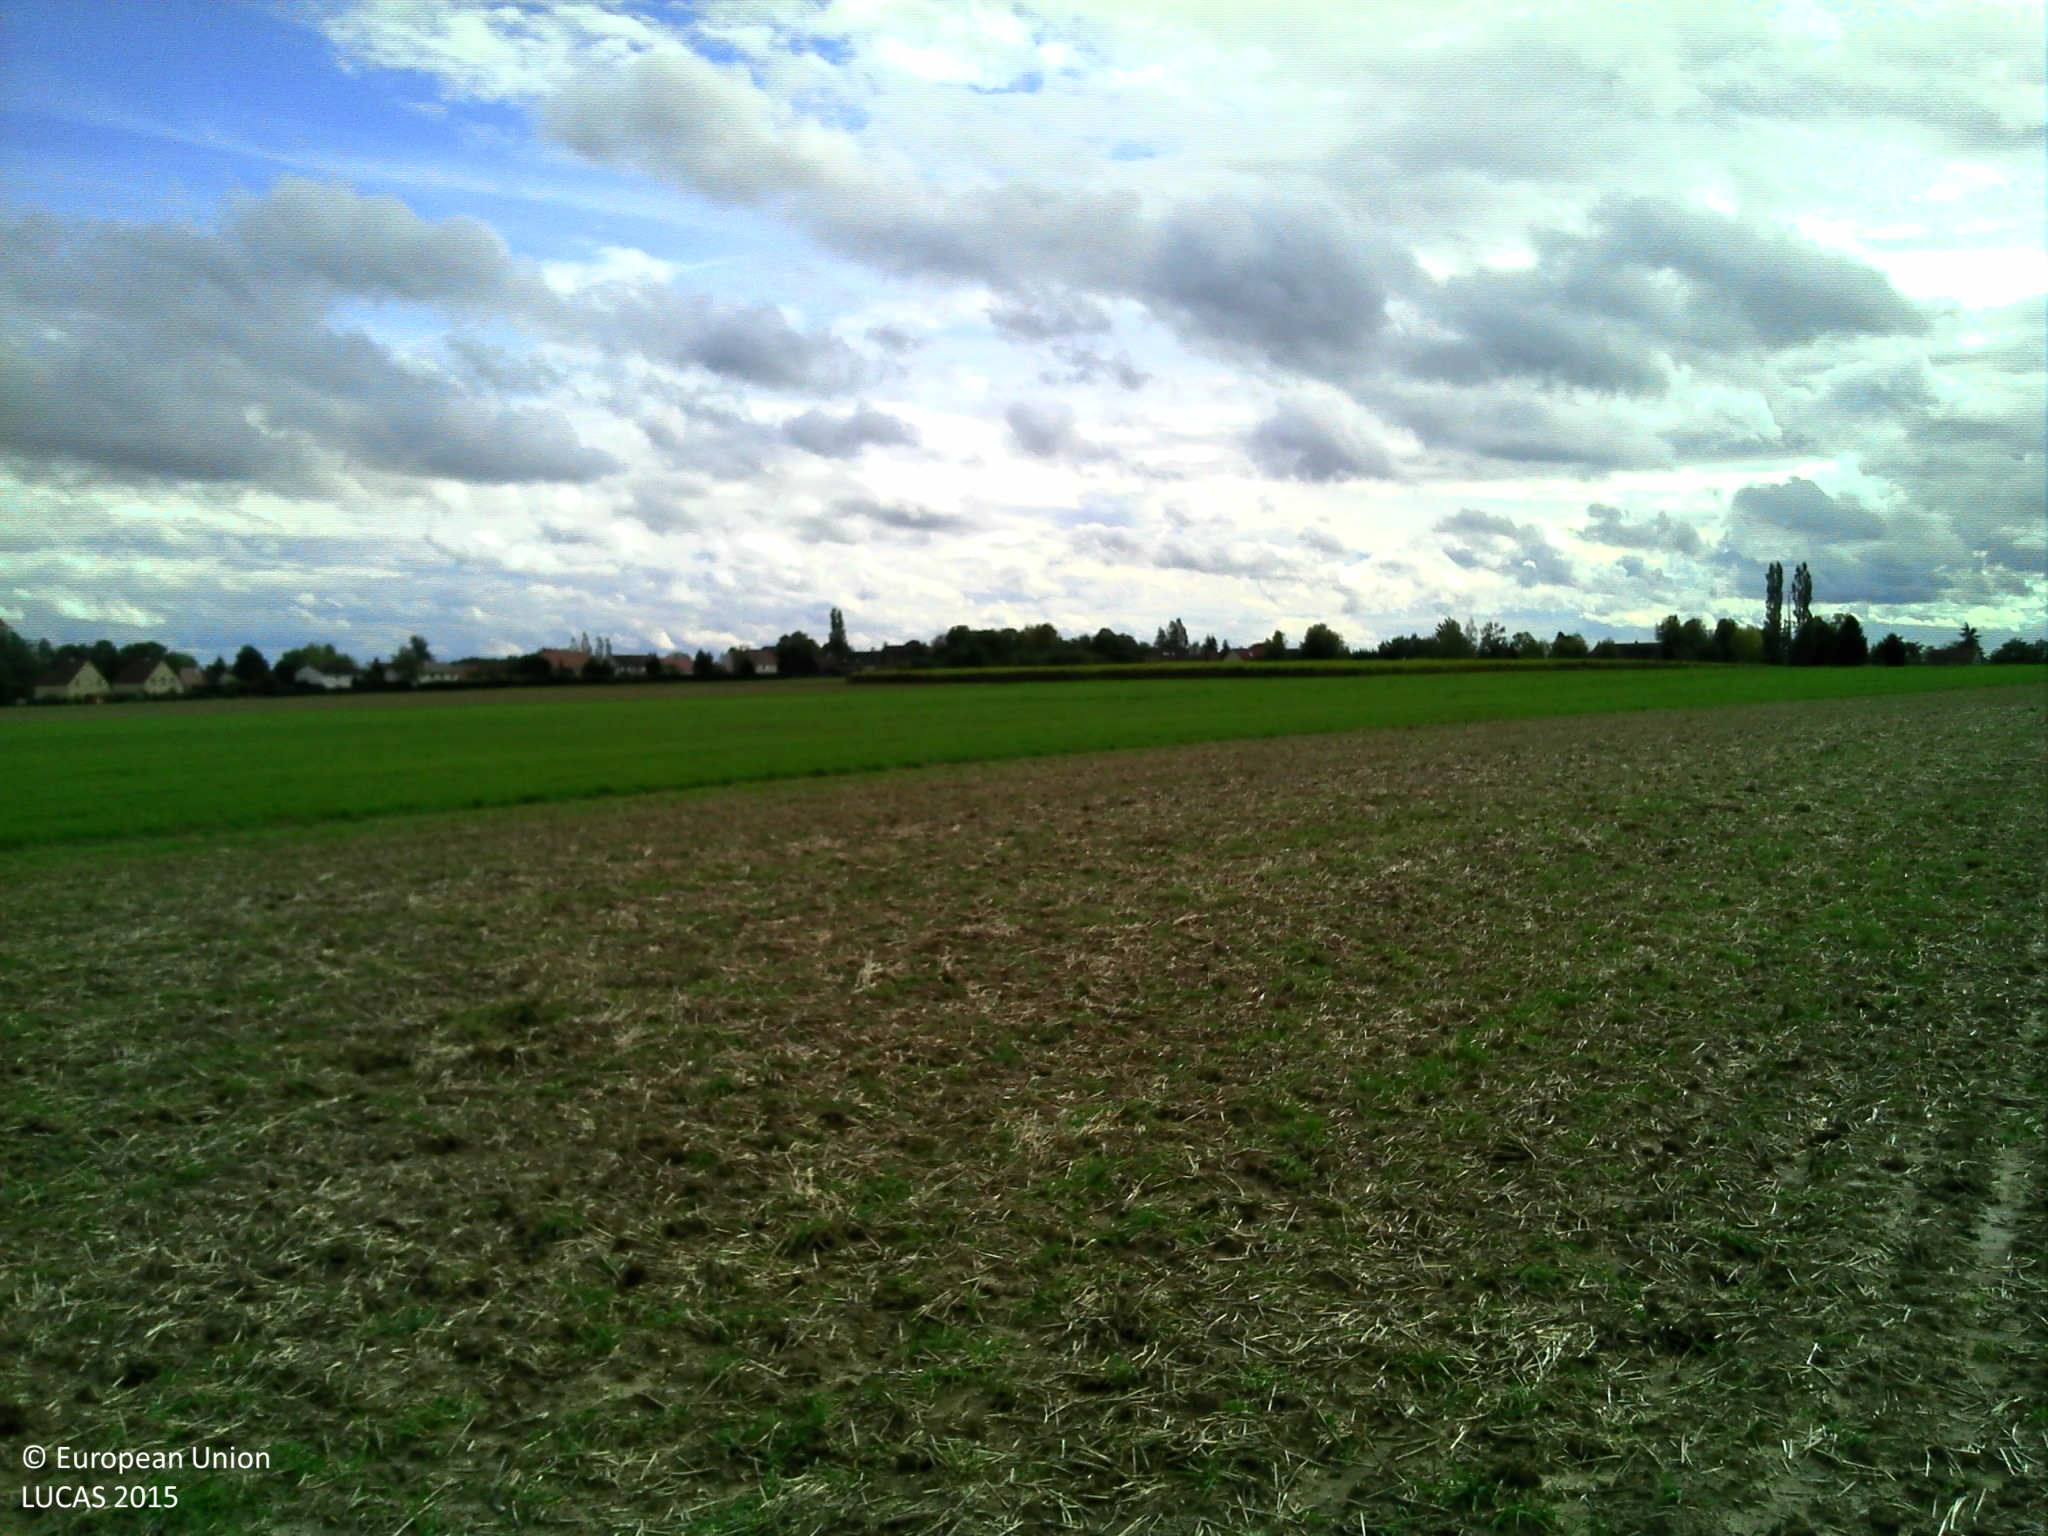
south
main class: Grassland
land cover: Spontaneously vegetated surfaces
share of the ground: 25 - 50 %
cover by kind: unconsolidated bare surface 60 %, herbaceous plants 40 %
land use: Agriculture (excluding fallow land and kitchen gardens)
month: September
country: FR
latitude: 47.1006
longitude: 5.0072
